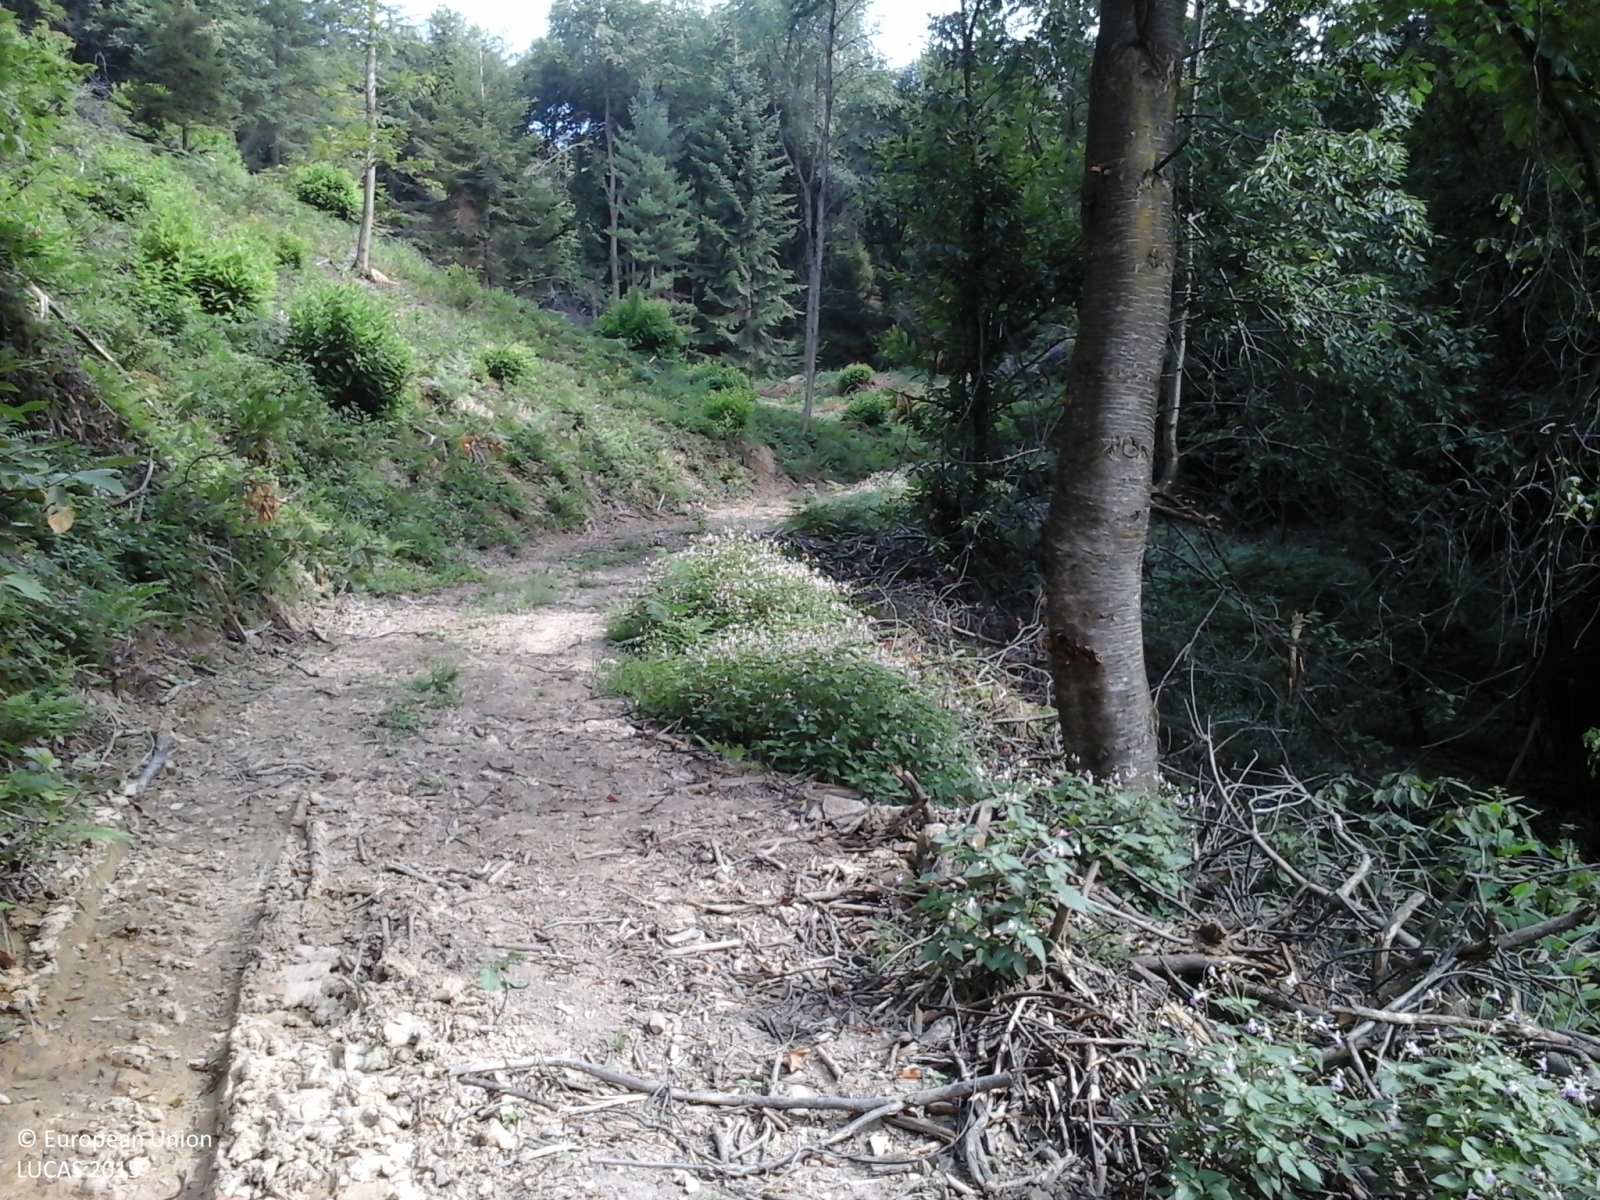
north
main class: Woodland
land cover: Broadleaved woodland
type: mesophytic deciduous forest
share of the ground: > 75 %
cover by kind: broadleaved forest trees 80 %, shrubs 15 %, herbaceous plants 5 %
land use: Forestry
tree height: > 5 m
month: July
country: IT
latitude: 44.3062
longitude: 7.6609
